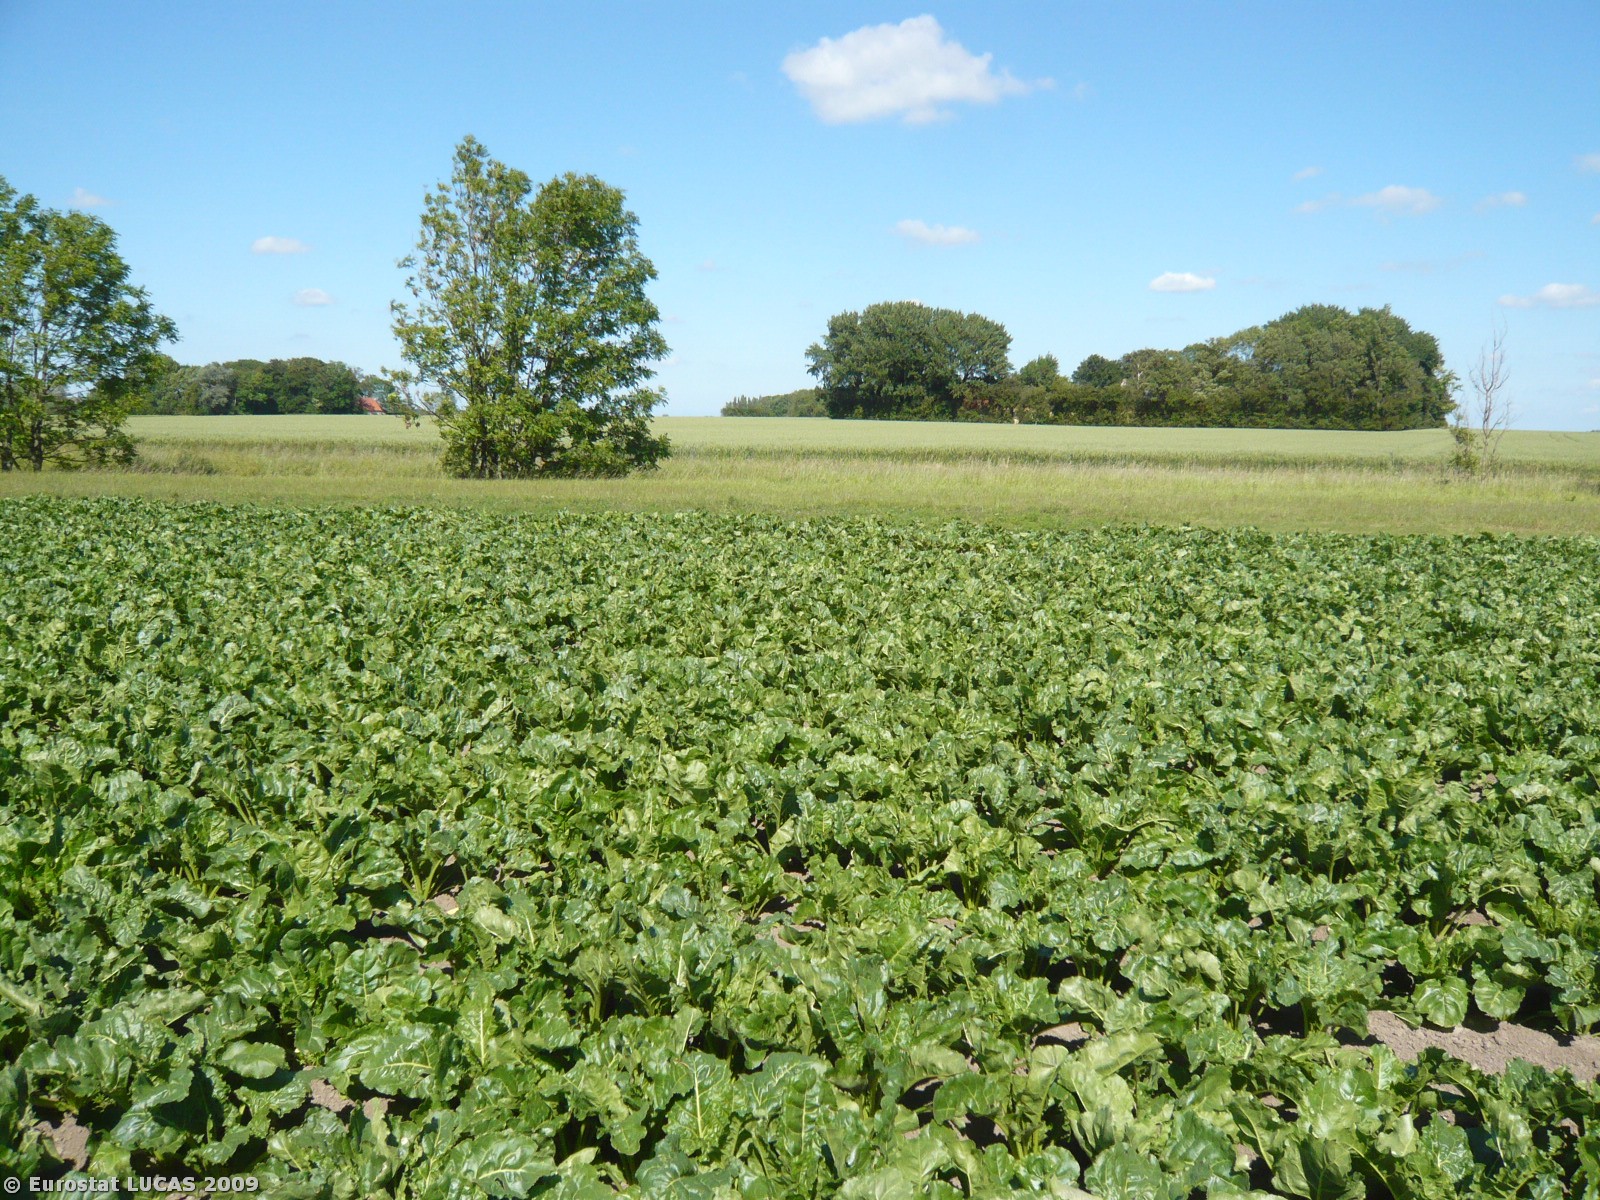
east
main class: Cropland
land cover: Sugar beet
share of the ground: > 75 %
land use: Agriculture (excluding fallow land and kitchen gardens)
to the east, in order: Sugar beet; Grassland without tree/shrub cover; Tracks; Broadleaved woodland; Ditches and canals; Grassland without tree/shrub cover; Tracks; Common wheat
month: June
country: DK
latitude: 54.7980
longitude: 11.1969
